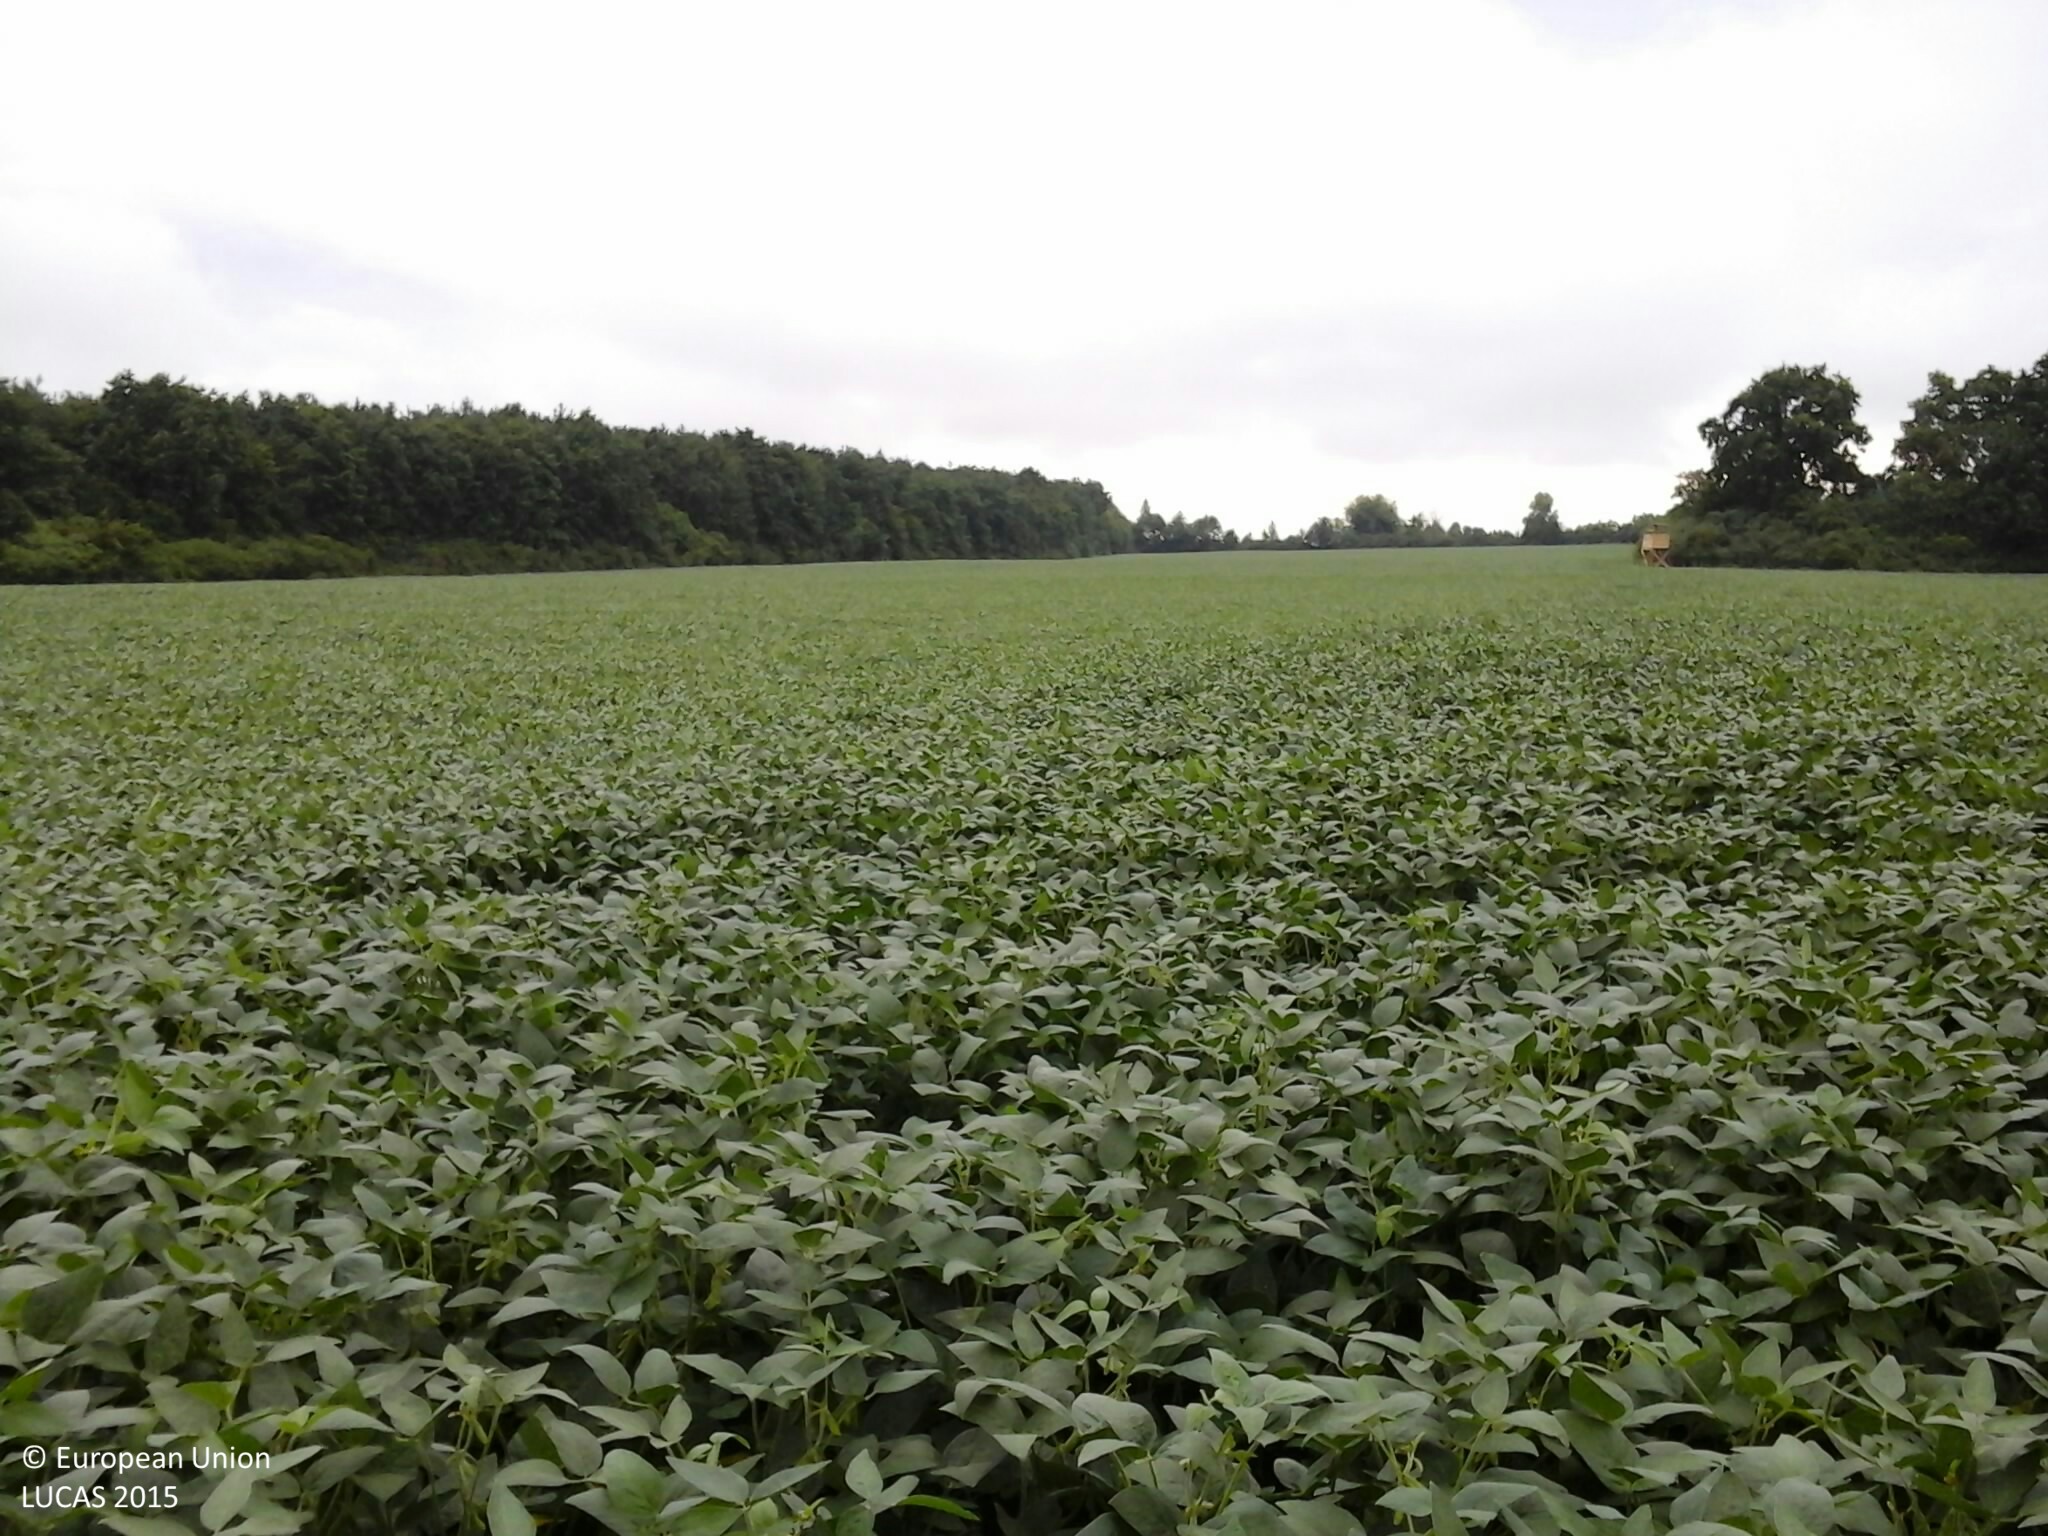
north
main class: Cropland
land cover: Soya
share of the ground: > 75 %
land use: Agriculture (excluding fallow land and kitchen gardens)
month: July
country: HU
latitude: 46.7180
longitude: 16.4250
